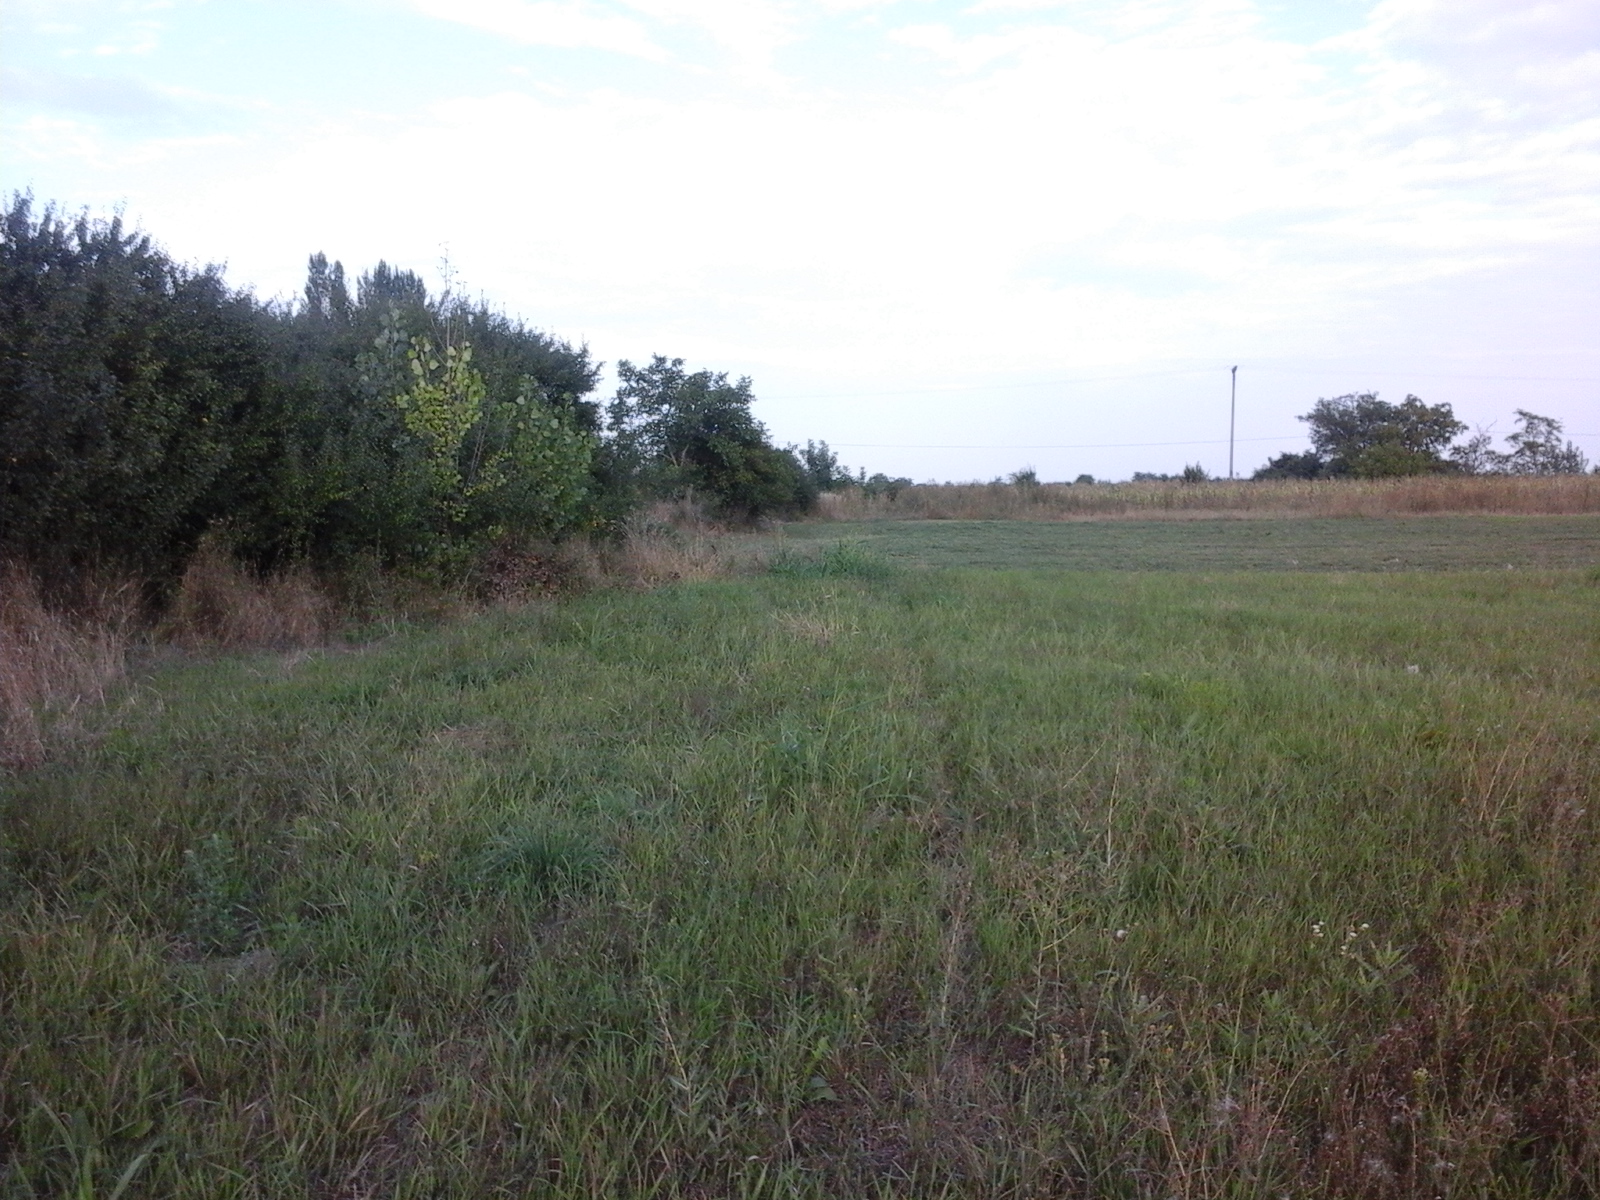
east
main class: Grassland
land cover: Spontaneously vegetated surfaces
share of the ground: > 75 %
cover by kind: herbaceous plants 100 %
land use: Agriculture (excluding fallow land and kitchen gardens)
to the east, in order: Spontaneously vegetated surfaces; Lucerne; Spontaneously vegetated surfaces; Abandoned hedges; Spontaneously vegetated surfaces; Electric lines; Spontaneously vegetated surfaces; Paved roads, cycling and walking lanes; Spontaneously vegetated surfaces; Electric lines; Spontaneously vegetated surfaces; Ditches and canals; Spontaneously vegetated surfaces; Maize; Other bare soil
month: August
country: RO
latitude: 46.4449
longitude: 21.7693
